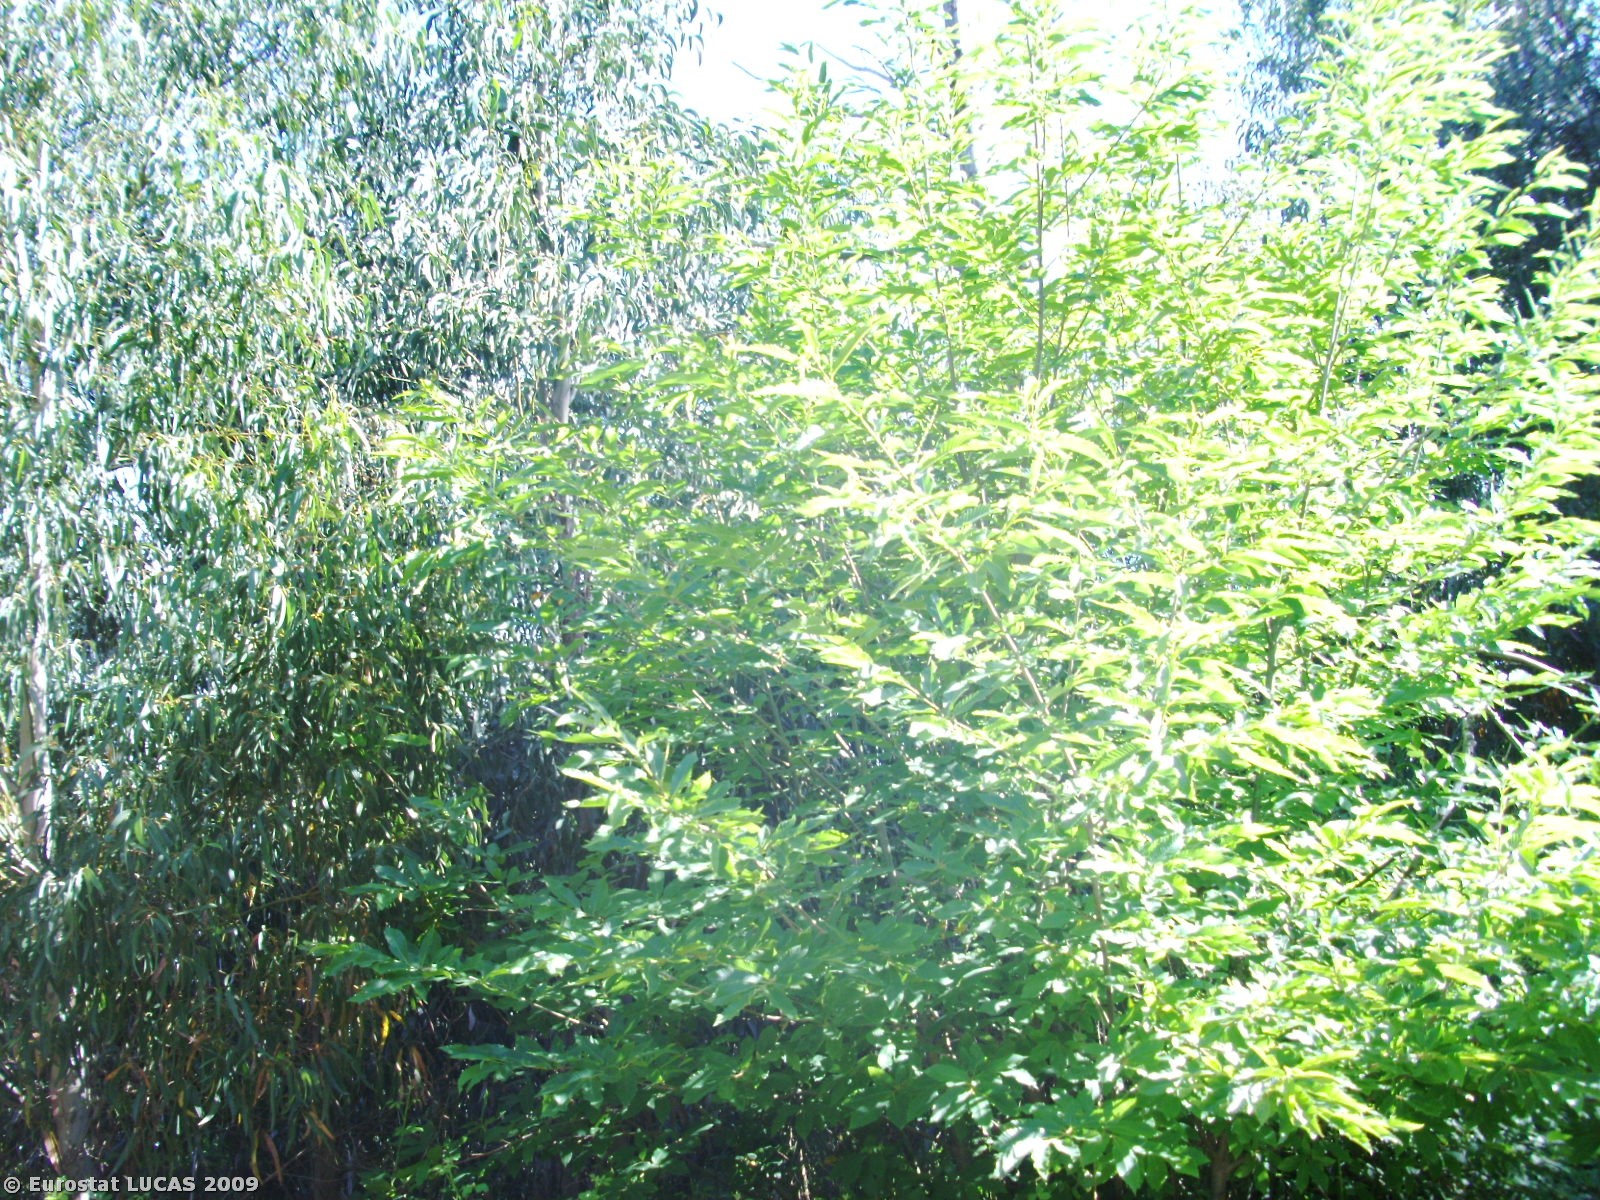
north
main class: Shrubland
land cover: Shrubland with sparse tree cover
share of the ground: > 75 %
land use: Nature reserves
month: June
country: PT
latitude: 37.3191
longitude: -8.5242
